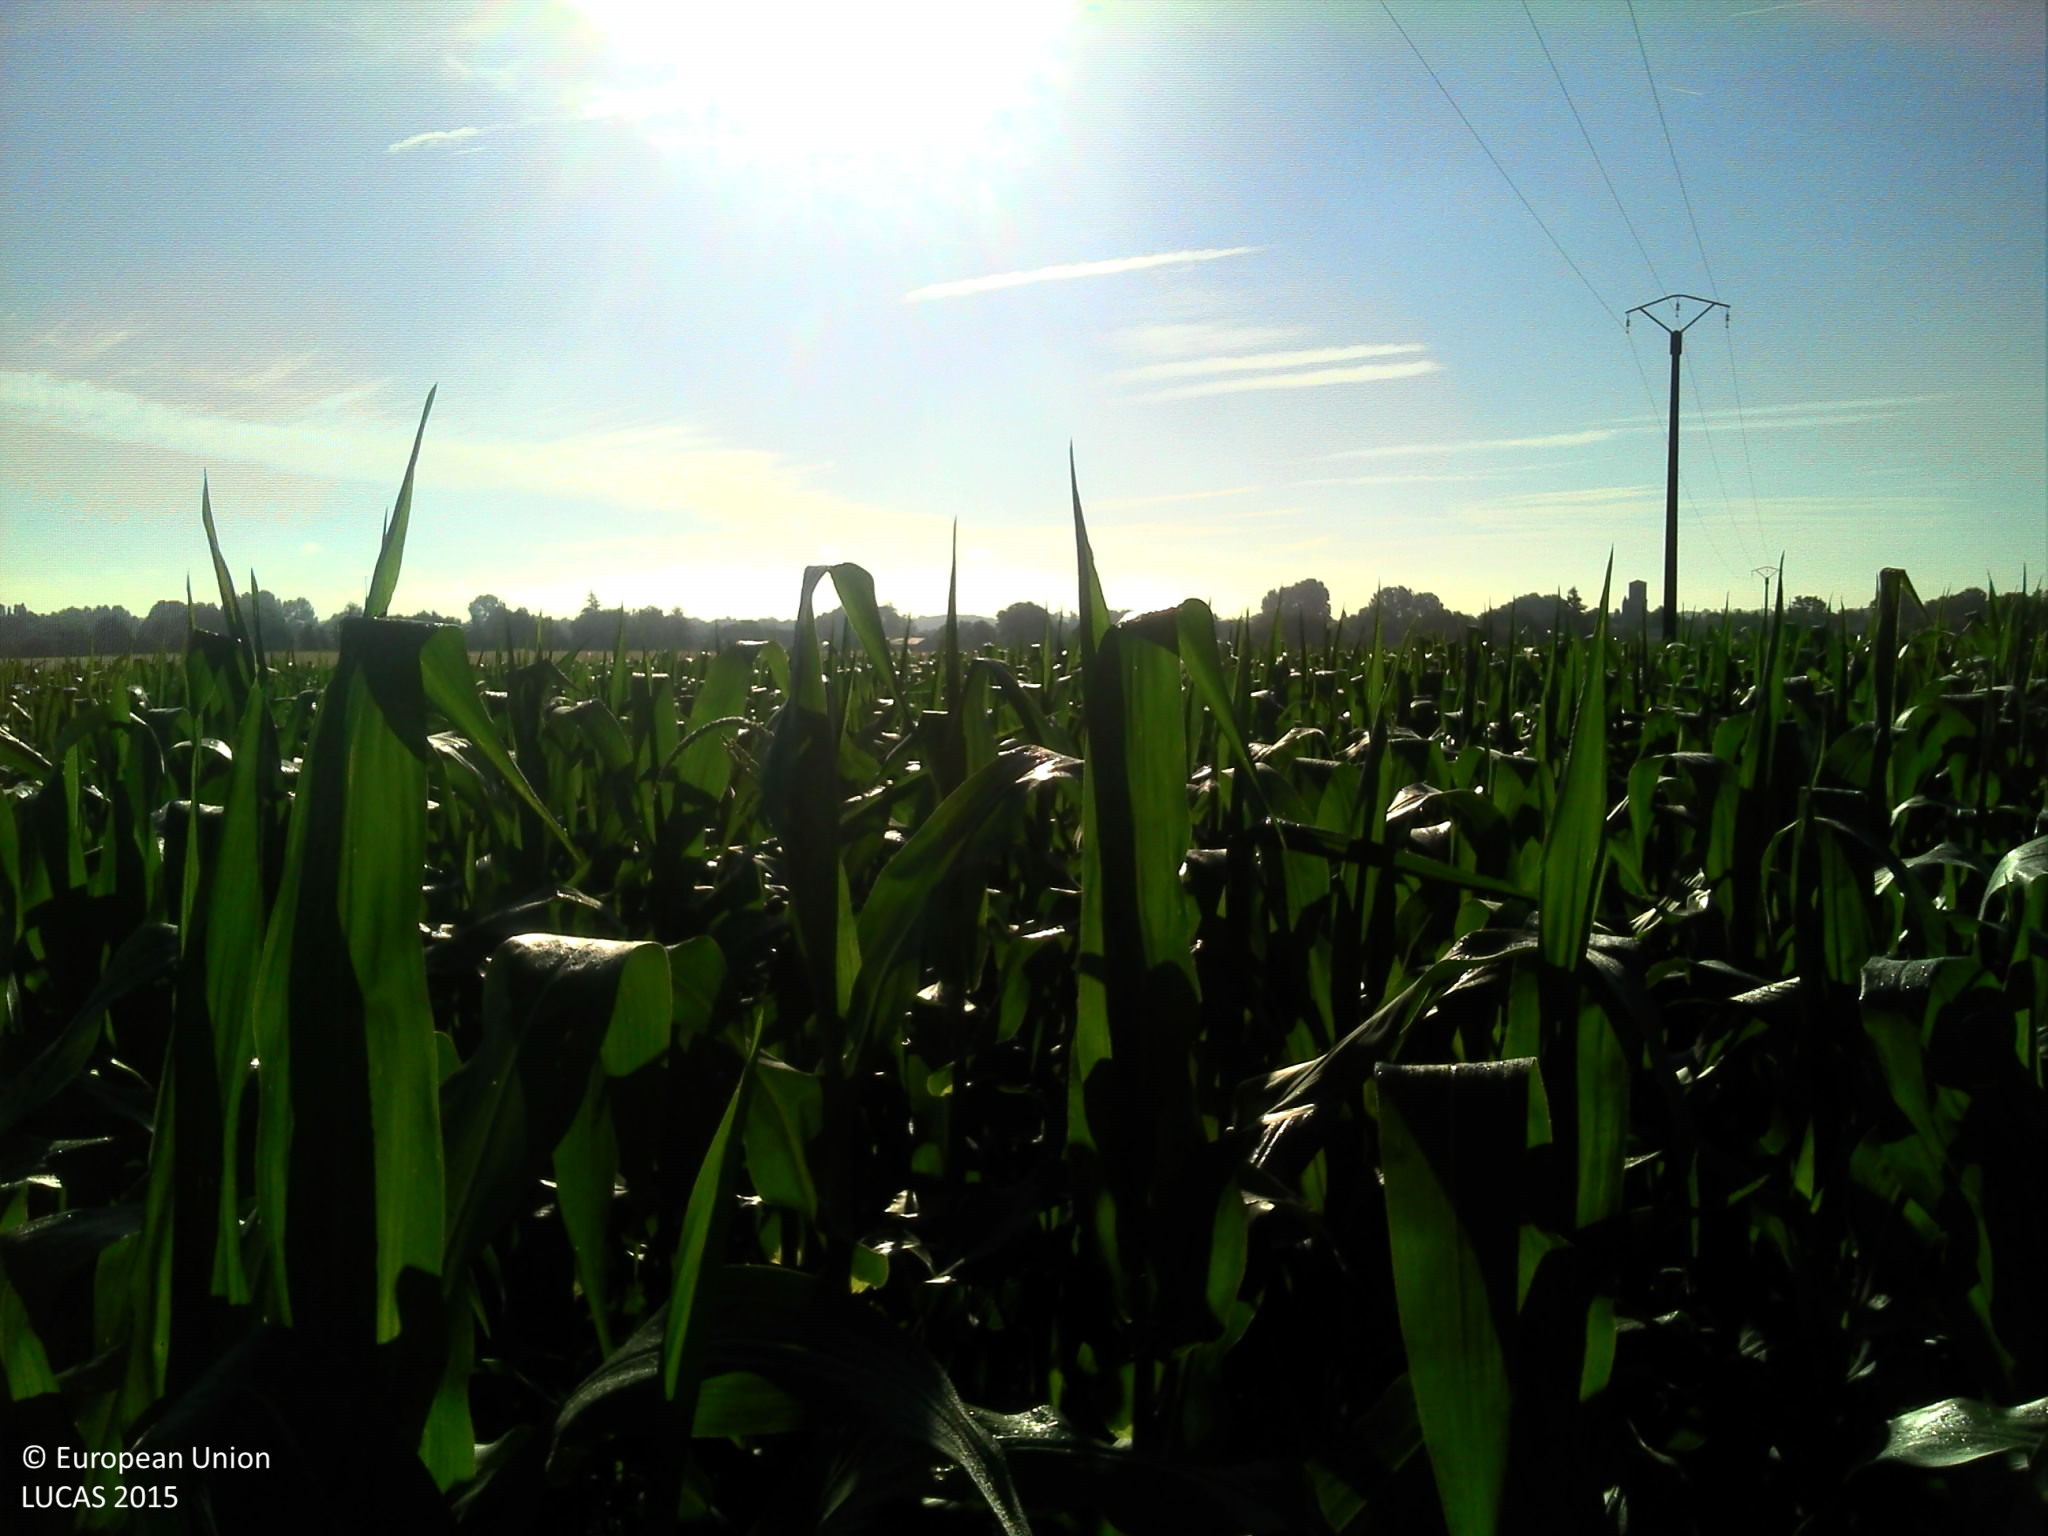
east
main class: Cropland
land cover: Maize
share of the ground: > 75 %
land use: Agriculture (excluding fallow land and kitchen gardens)
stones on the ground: 25 - 50 %
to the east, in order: Maize; Electric lines; Maize; Grass margins; Maize
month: June
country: FR
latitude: 45.6325
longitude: -0.8654
